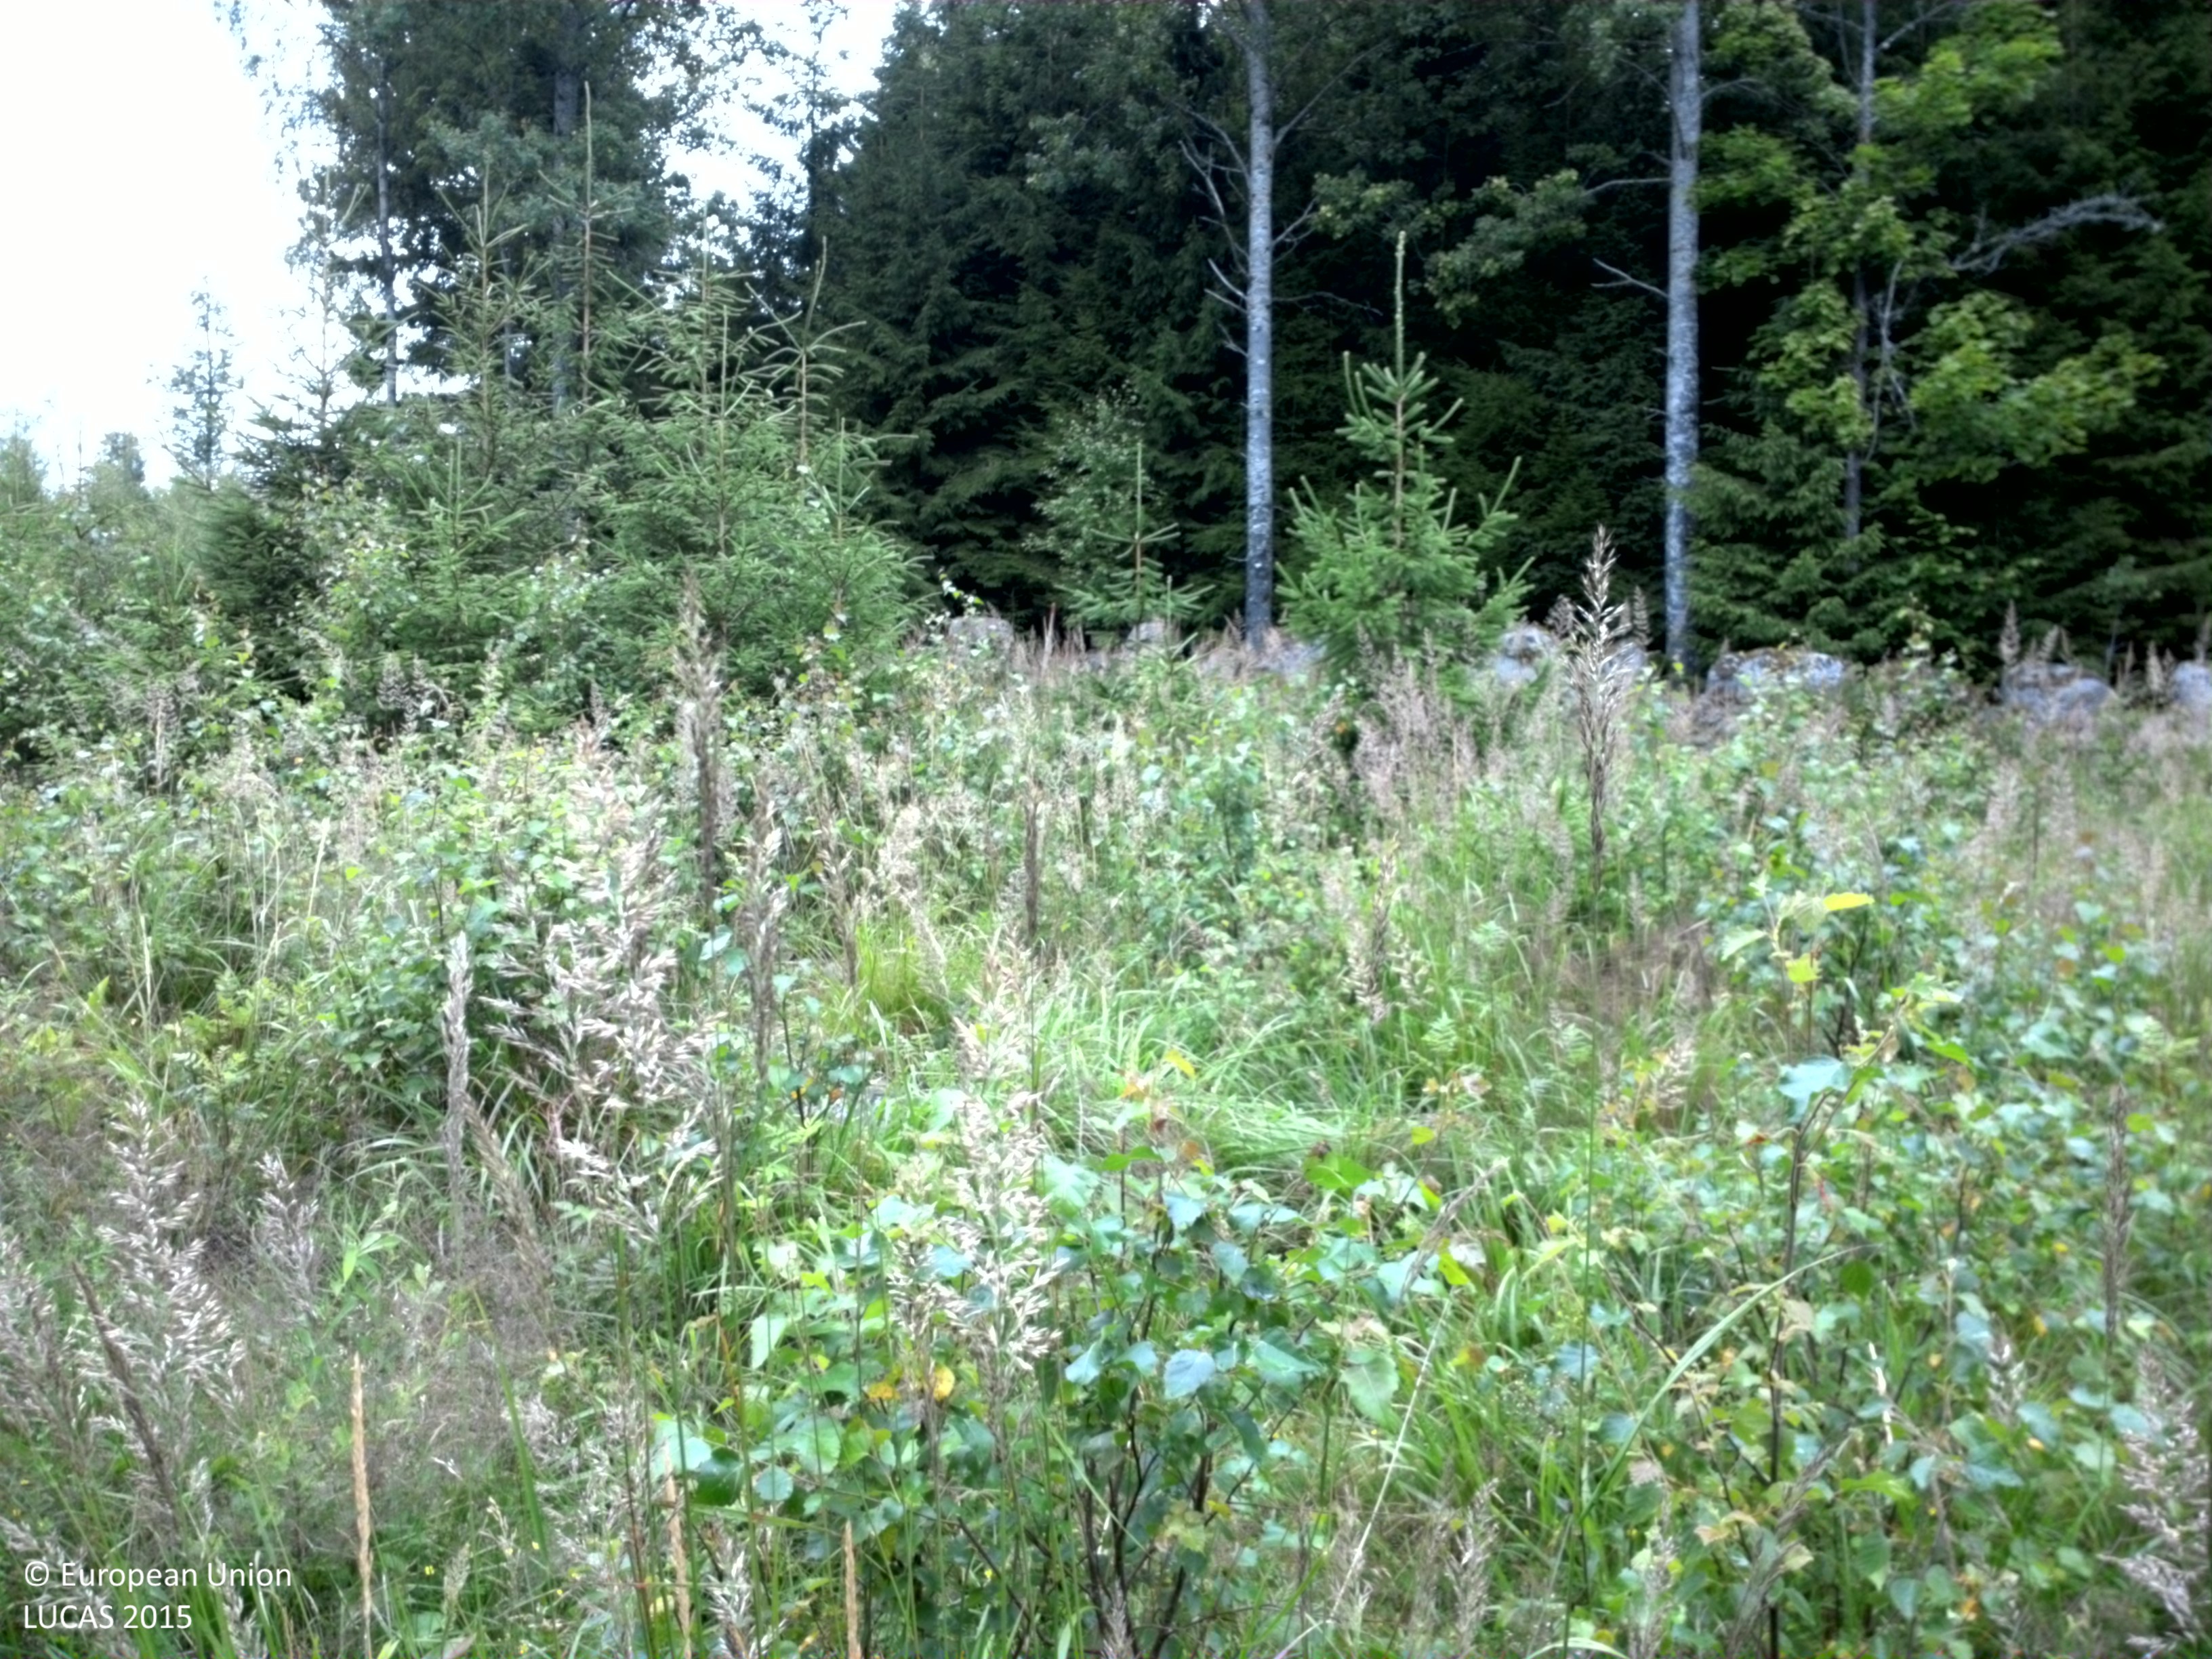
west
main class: Woodland
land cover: Spruce dominated mixed woodland
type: boreal forest
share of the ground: 50 - 75 %
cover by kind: coniferous forest trees 40 %, herbaceous plants 35 %, broadleaved forest trees 25 %
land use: Forestry
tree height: < 5 m
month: July
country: SE
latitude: 58.9026
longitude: 14.4536
